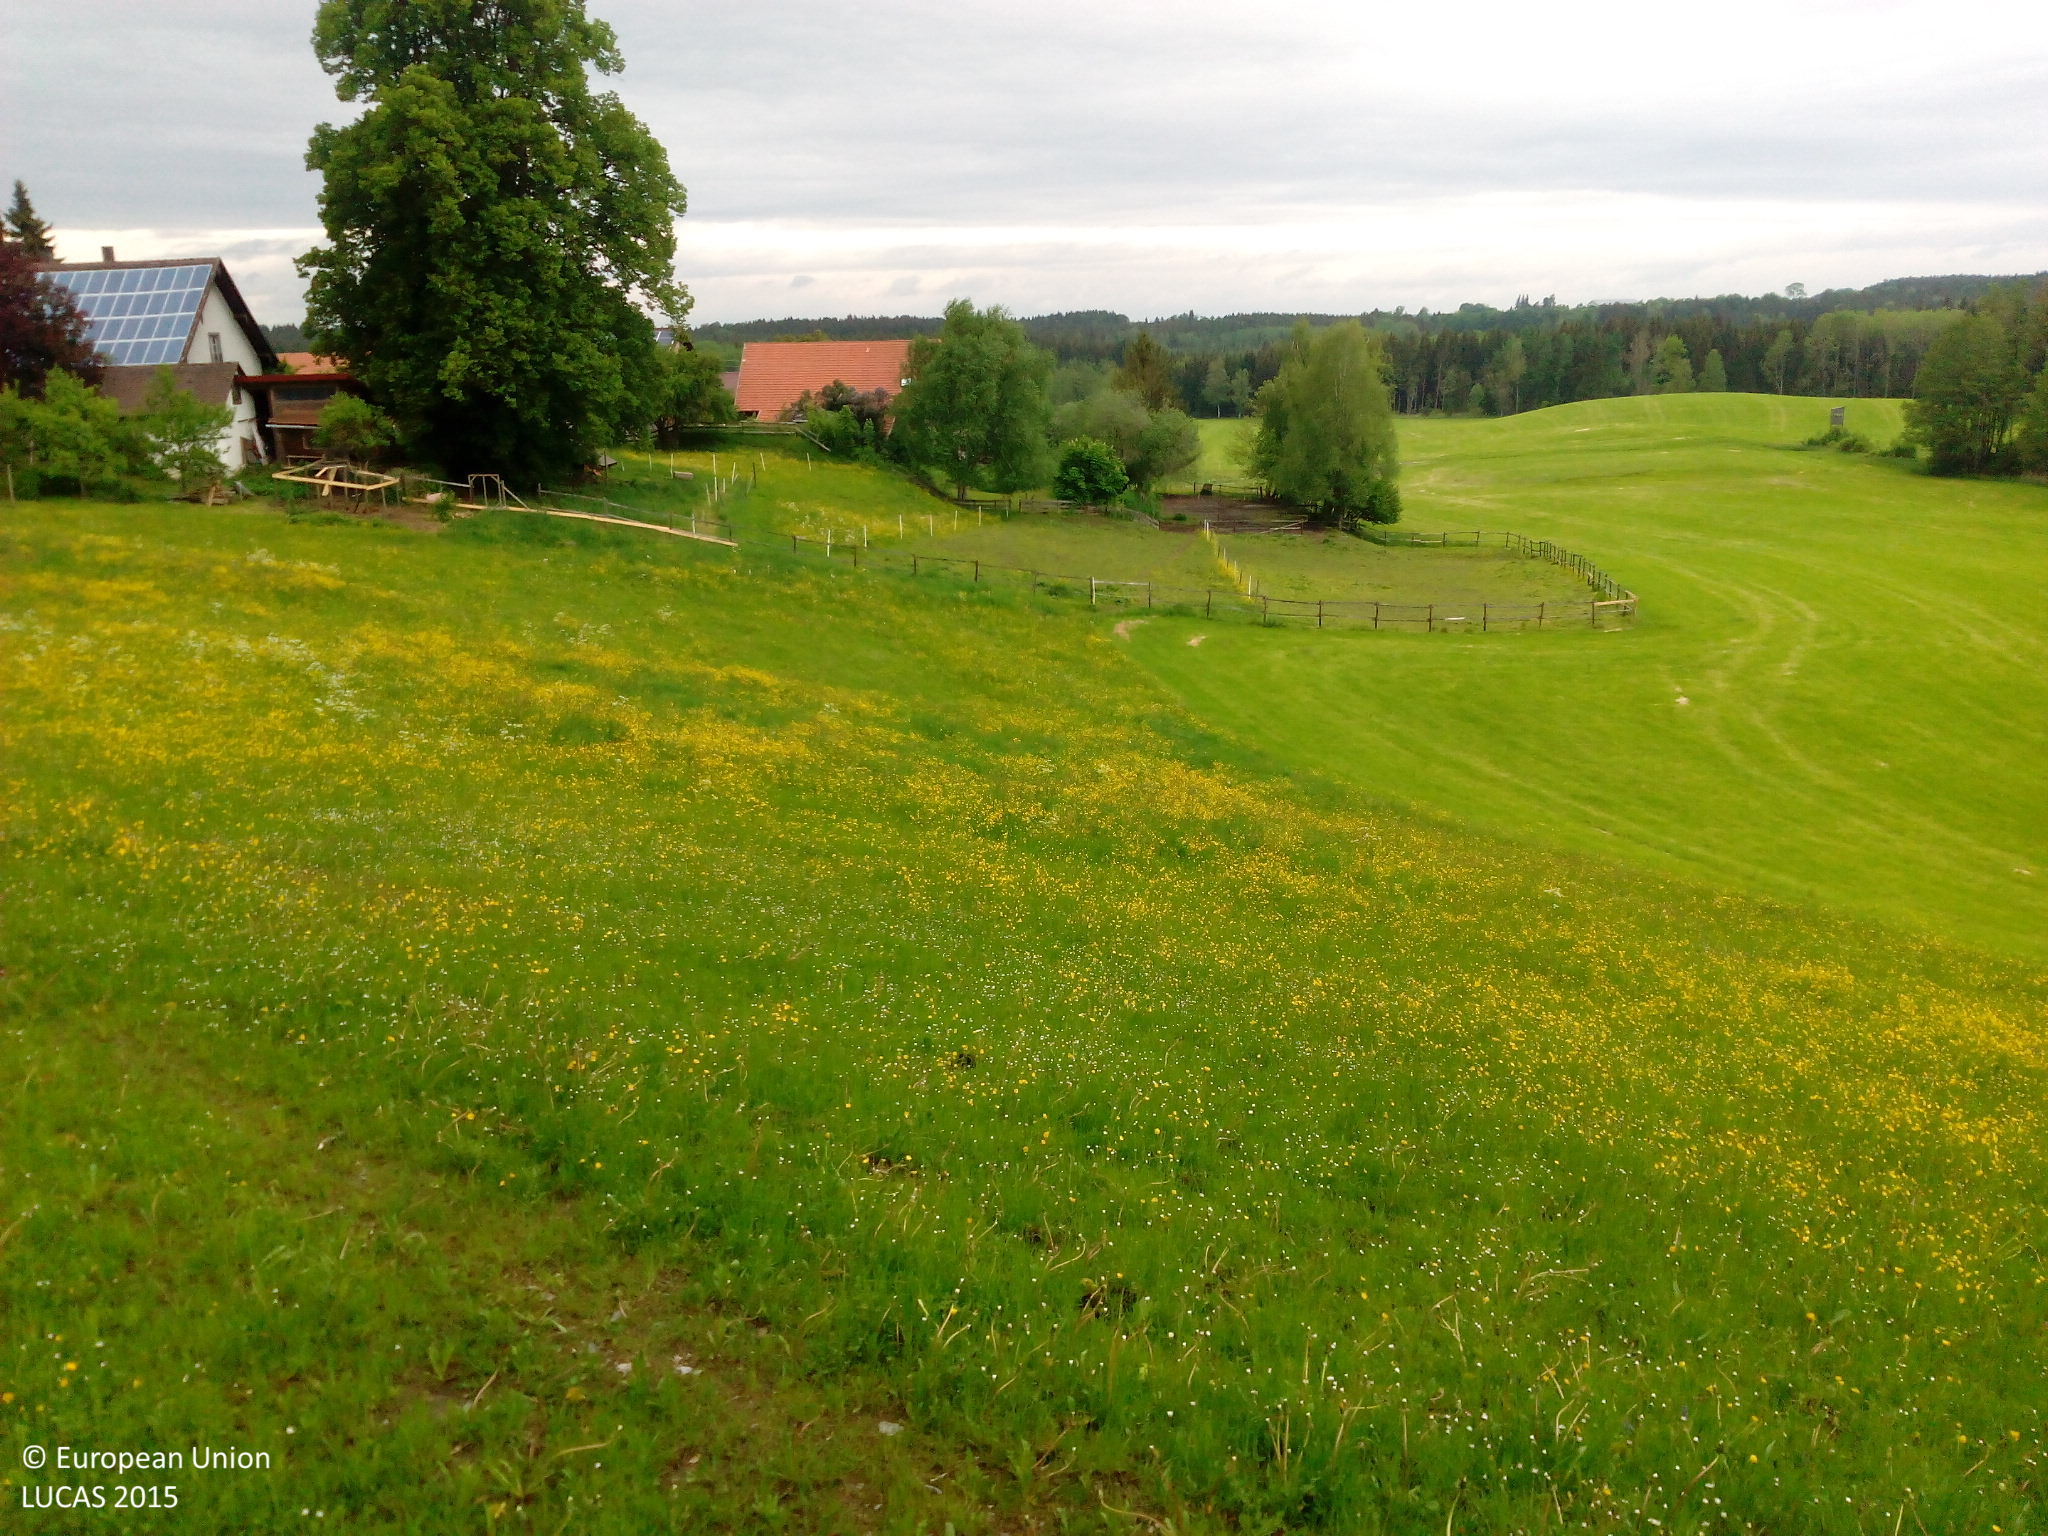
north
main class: Grassland
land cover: Grassland without tree/shrub cover
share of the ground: > 75 %
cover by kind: herbaceous plants 100 %
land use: Agriculture (excluding fallow land and kitchen gardens)
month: May
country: DE
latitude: 47.8275
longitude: 9.8532
